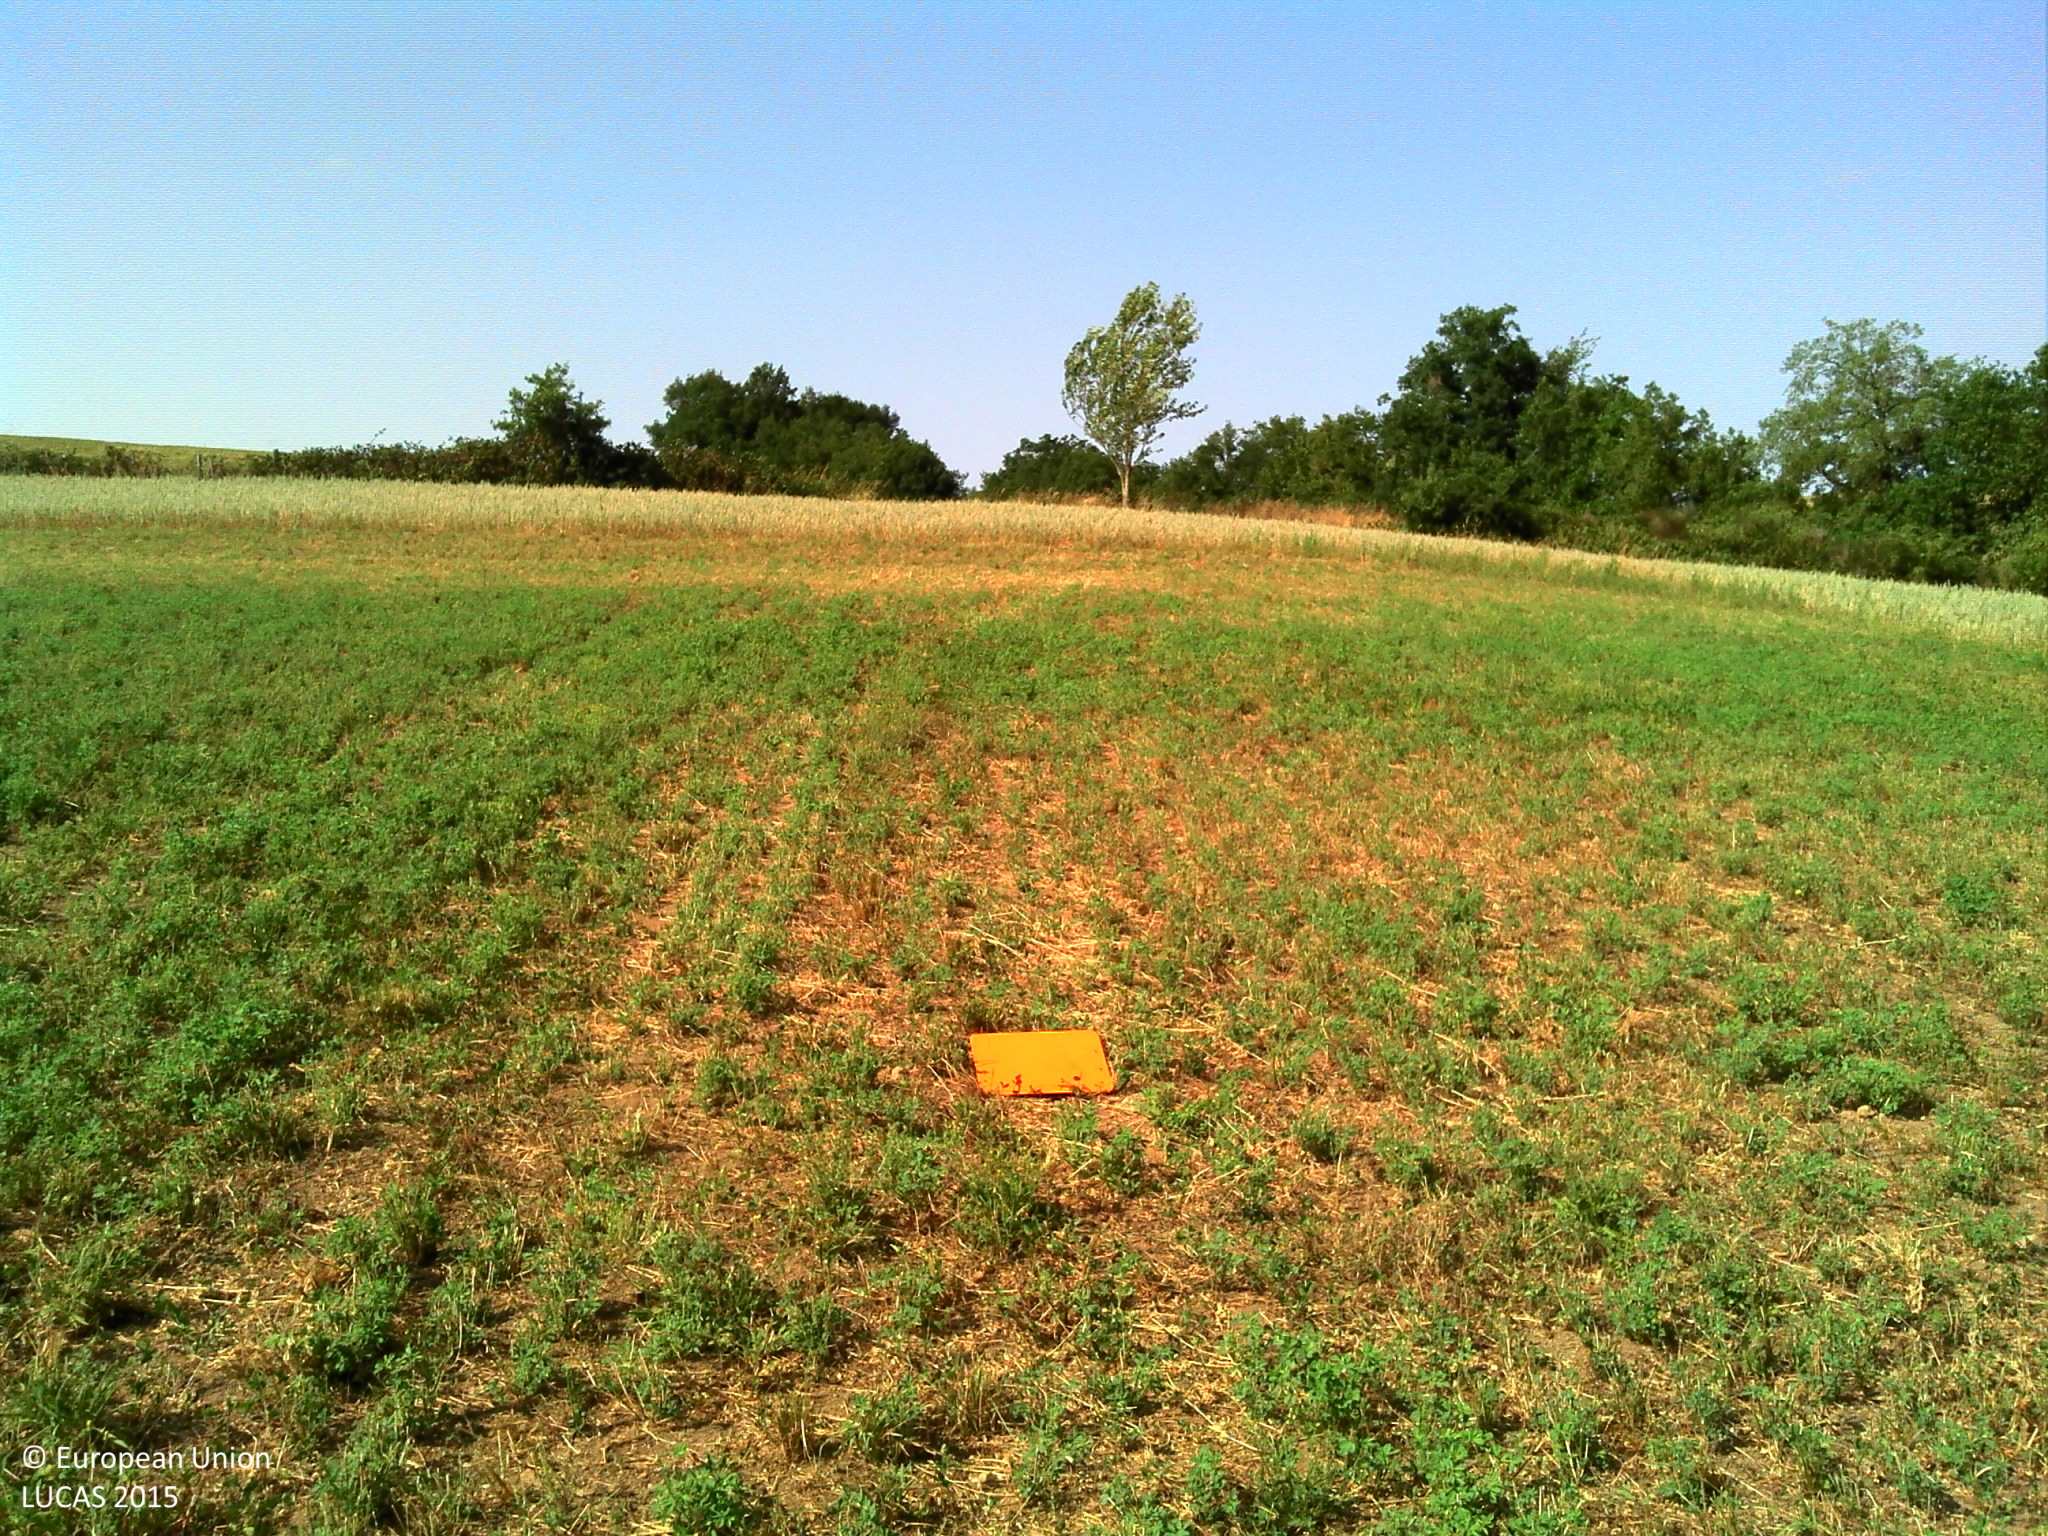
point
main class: Cropland
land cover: Lucerne
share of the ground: > 75 %
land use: Agriculture (excluding fallow land and kitchen gardens)
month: July
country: FR
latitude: 44.1399
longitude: 2.5917
